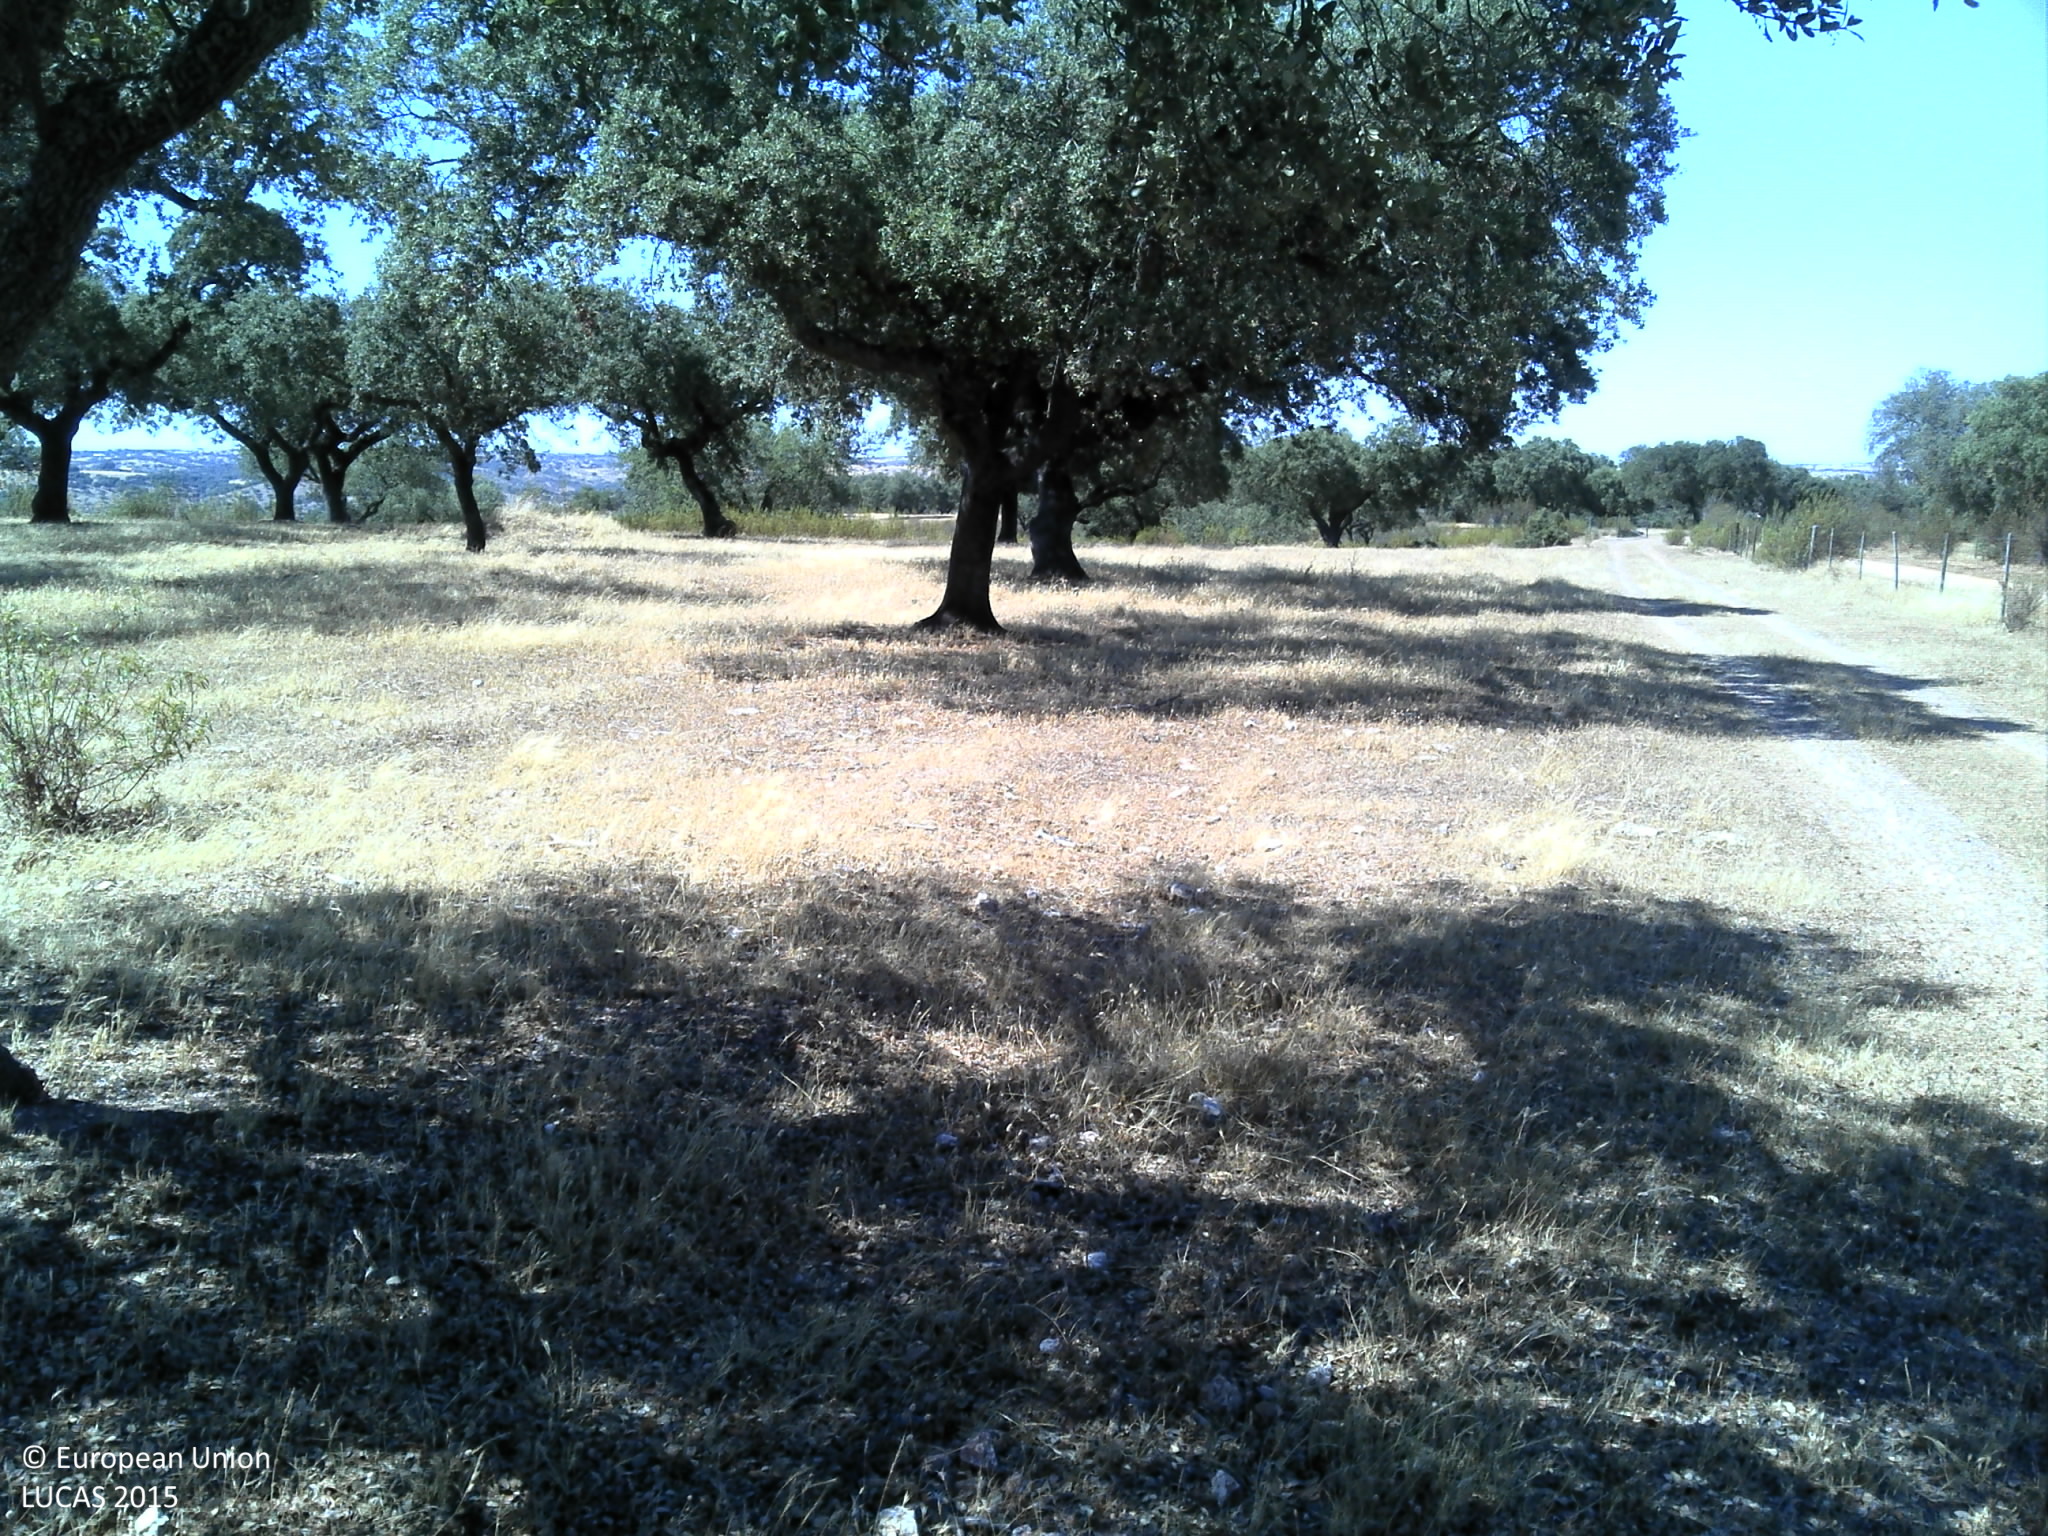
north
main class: Woodland
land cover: Broadleaved woodland
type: broadleaved evergreen forest
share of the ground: 25 - 50 %
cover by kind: broadleaved forest trees 45 %, unconsolidated bare surface 35 %, herbaceous plants 20 %
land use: Forestry
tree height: > 5 m
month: July
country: PT
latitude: 38.1576
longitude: -7.3311
